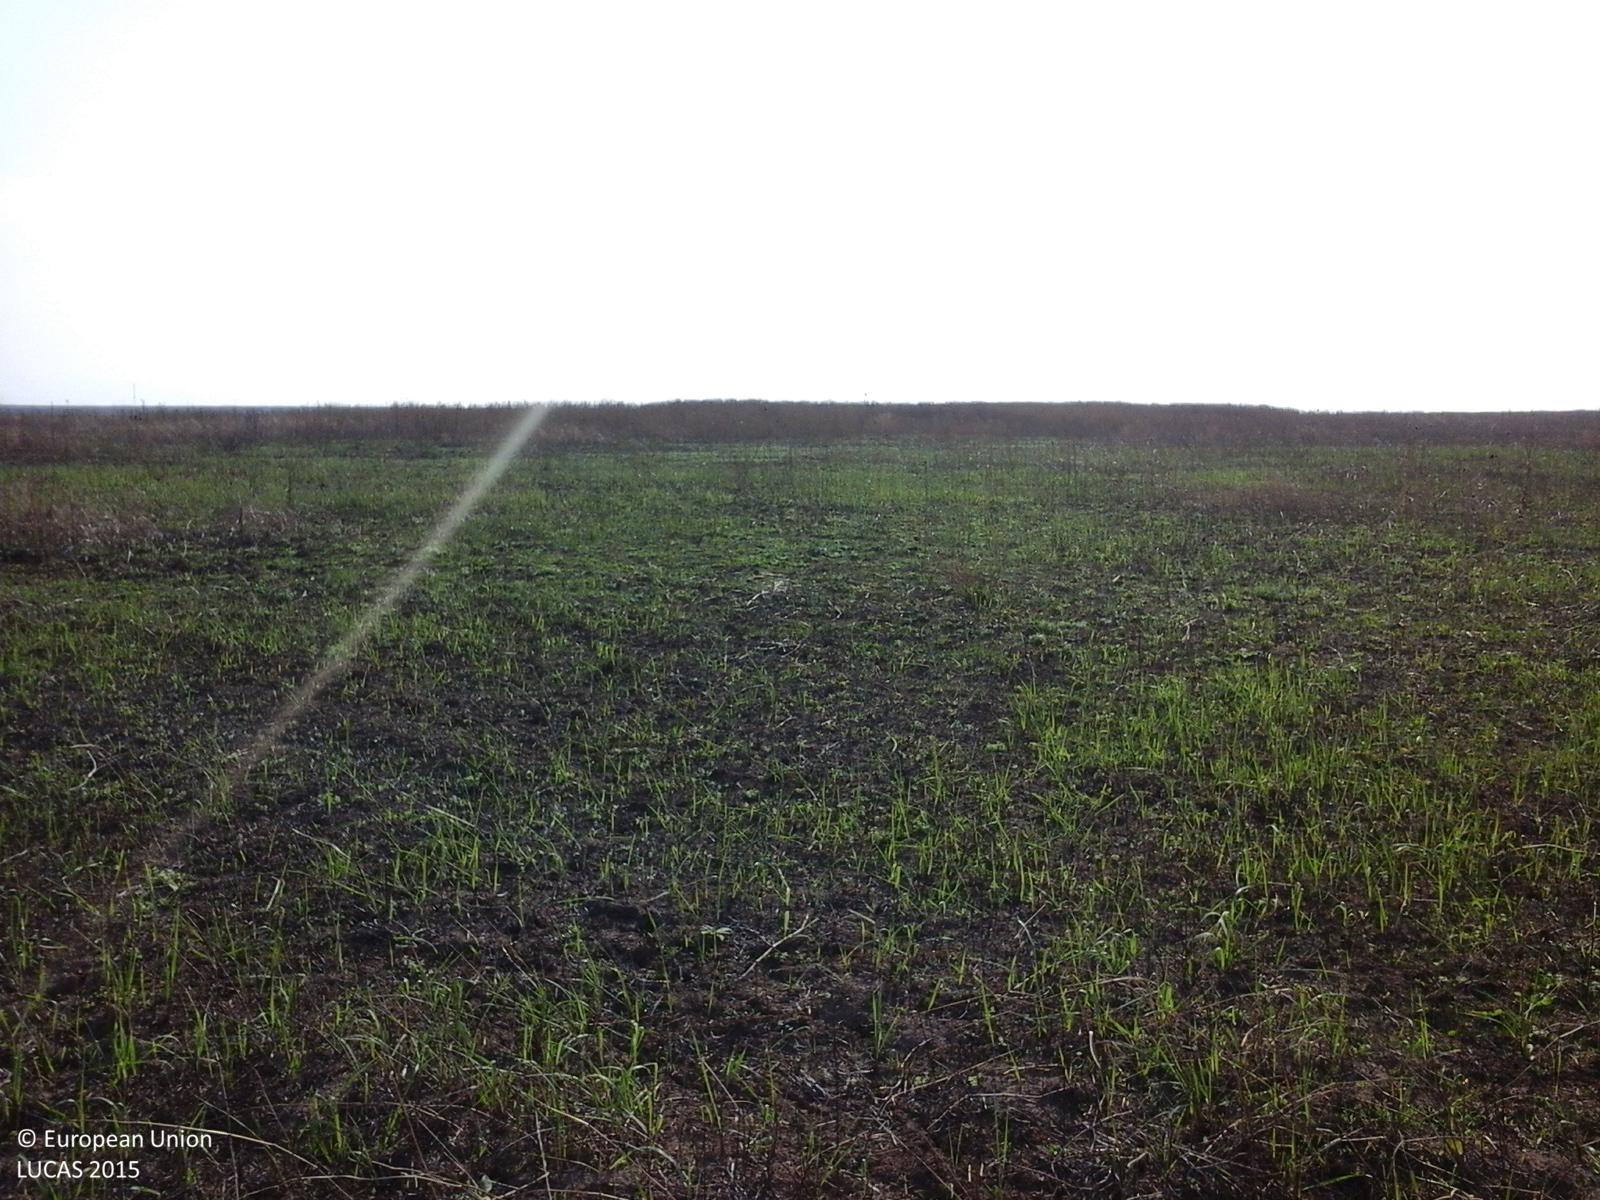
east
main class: Grassland
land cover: Grassland without tree/shrub cover
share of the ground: > 75 %
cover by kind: herbaceous plants 100 %
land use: Agriculture (excluding fallow land and kitchen gardens)
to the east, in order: Grassland without tree/shrub cover; Spontaneously vegetated surfaces
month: August
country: RO
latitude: 46.0616
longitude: 21.4492
